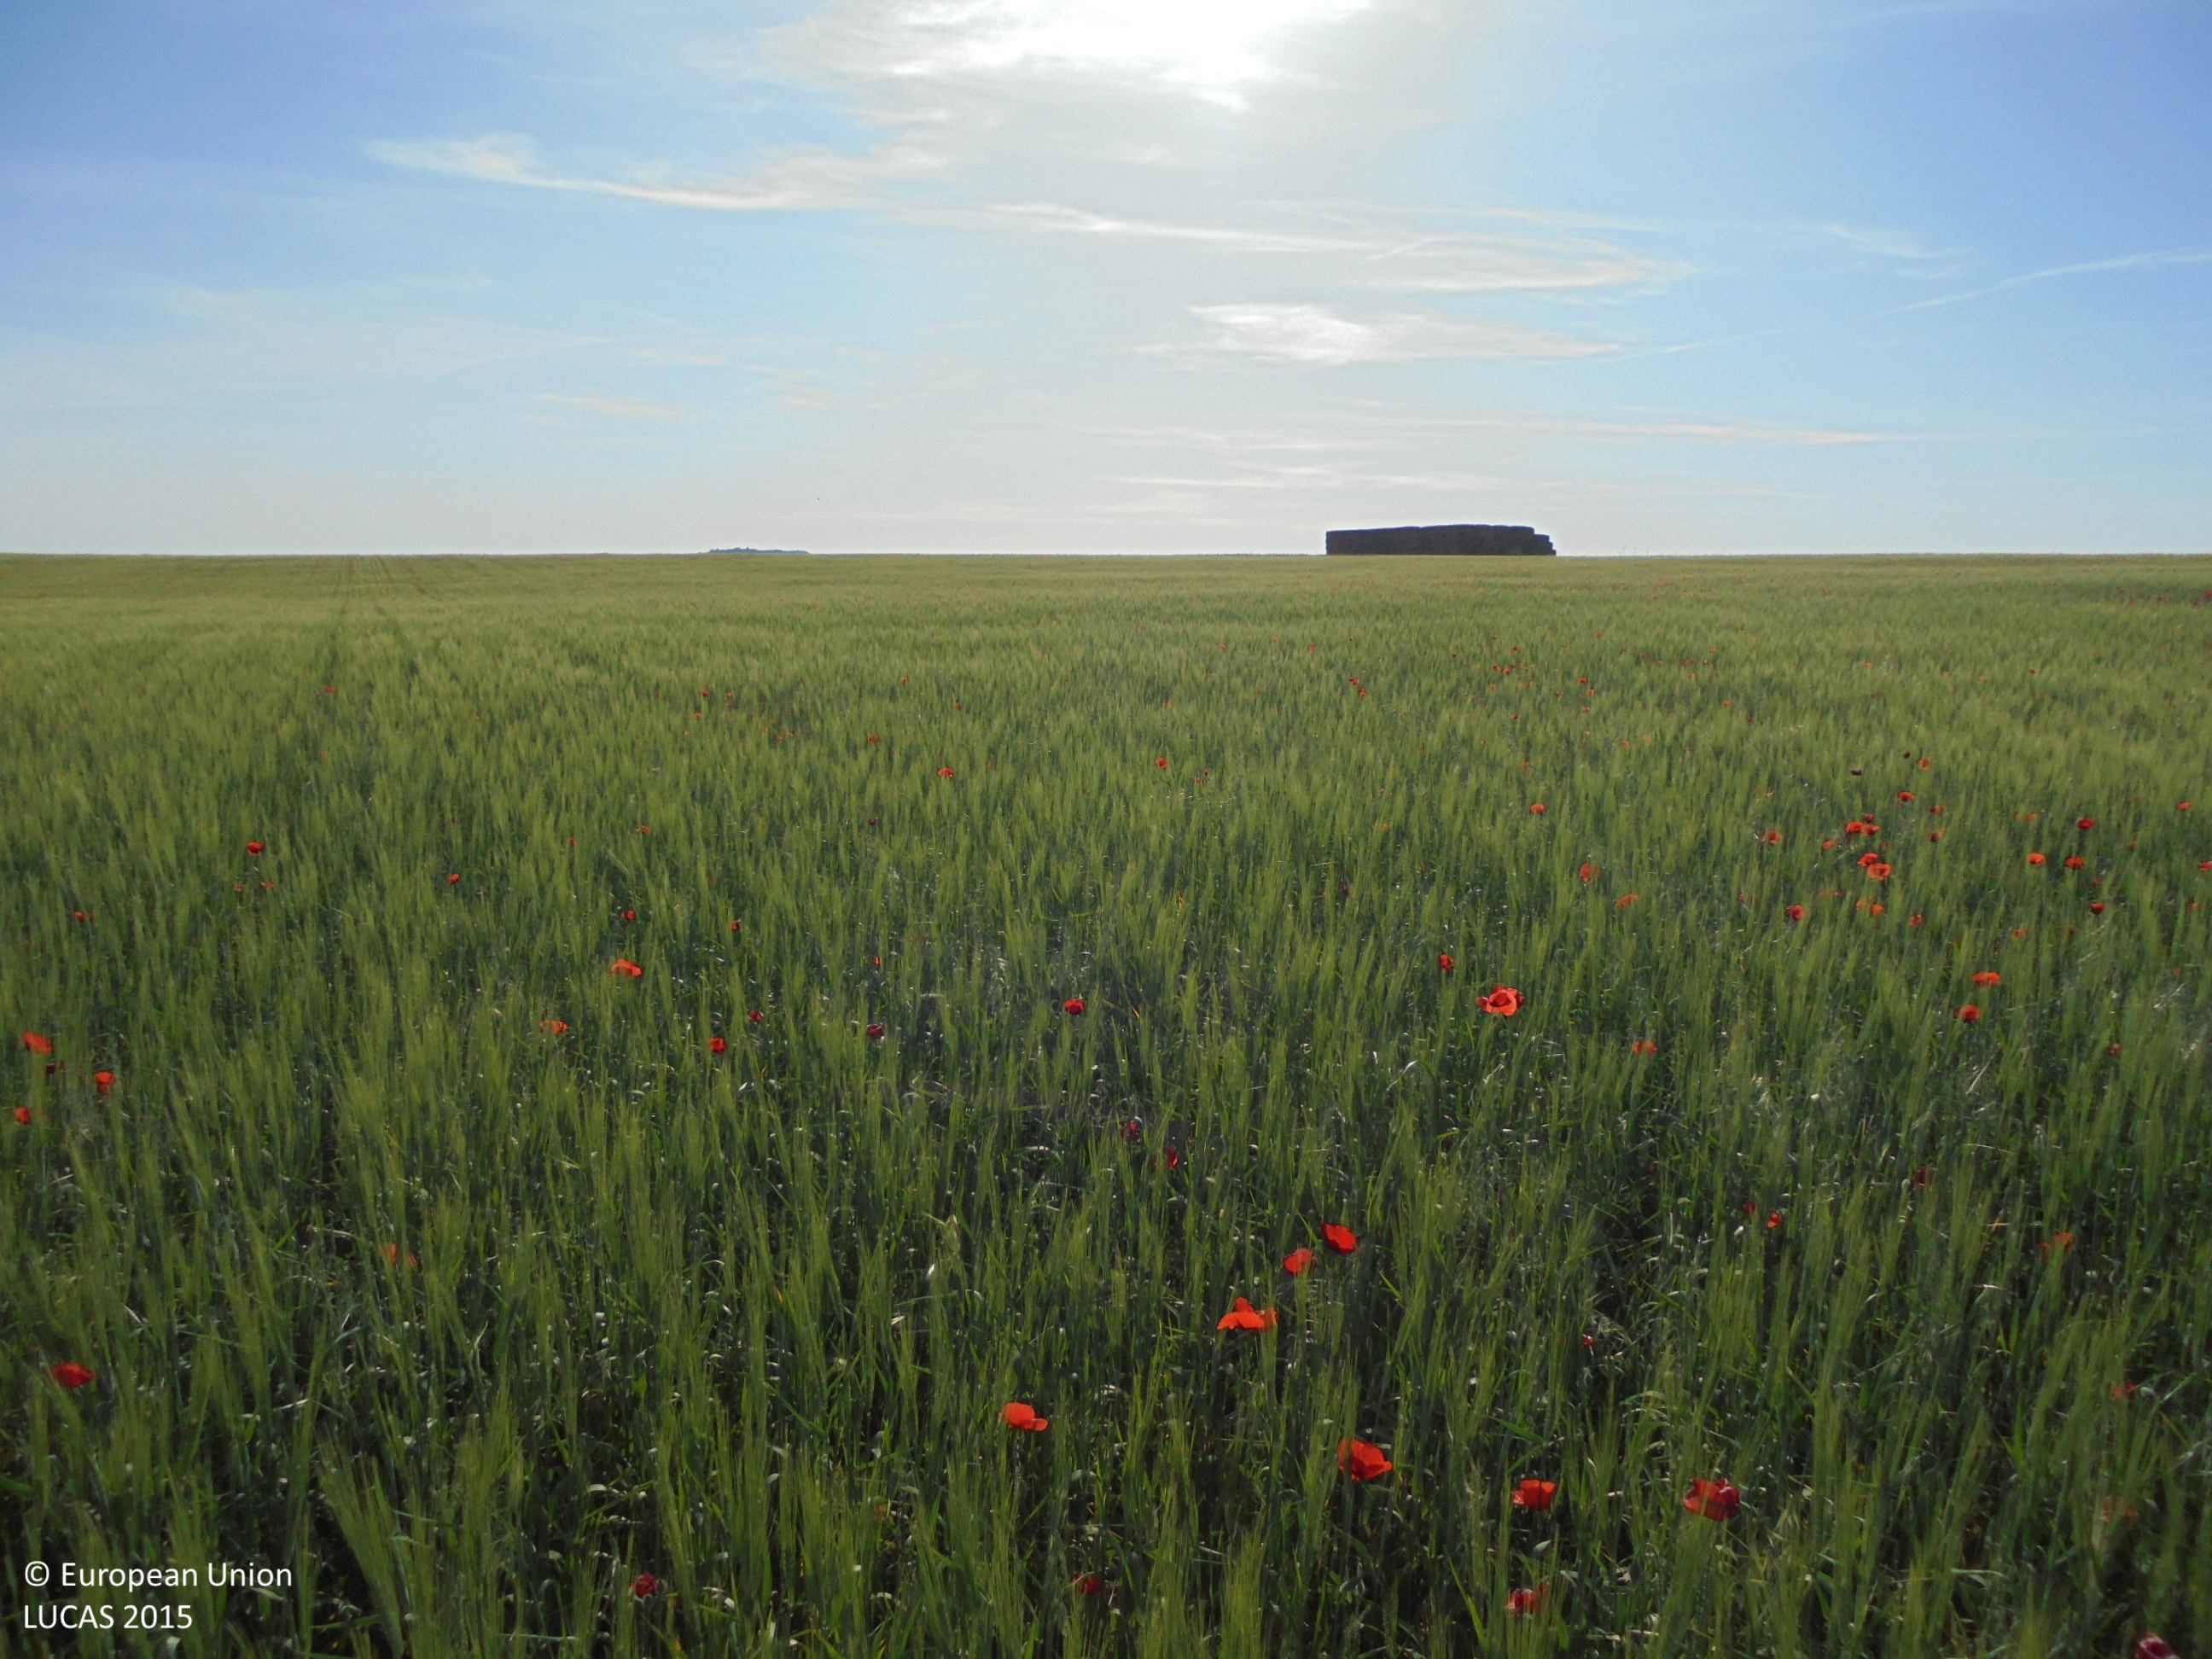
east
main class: Cropland
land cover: Durum wheat
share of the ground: > 75 %
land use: Agriculture (excluding fallow land and kitchen gardens)
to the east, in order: Durum wheat
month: May
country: ES
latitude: 39.1157
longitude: -1.4840
